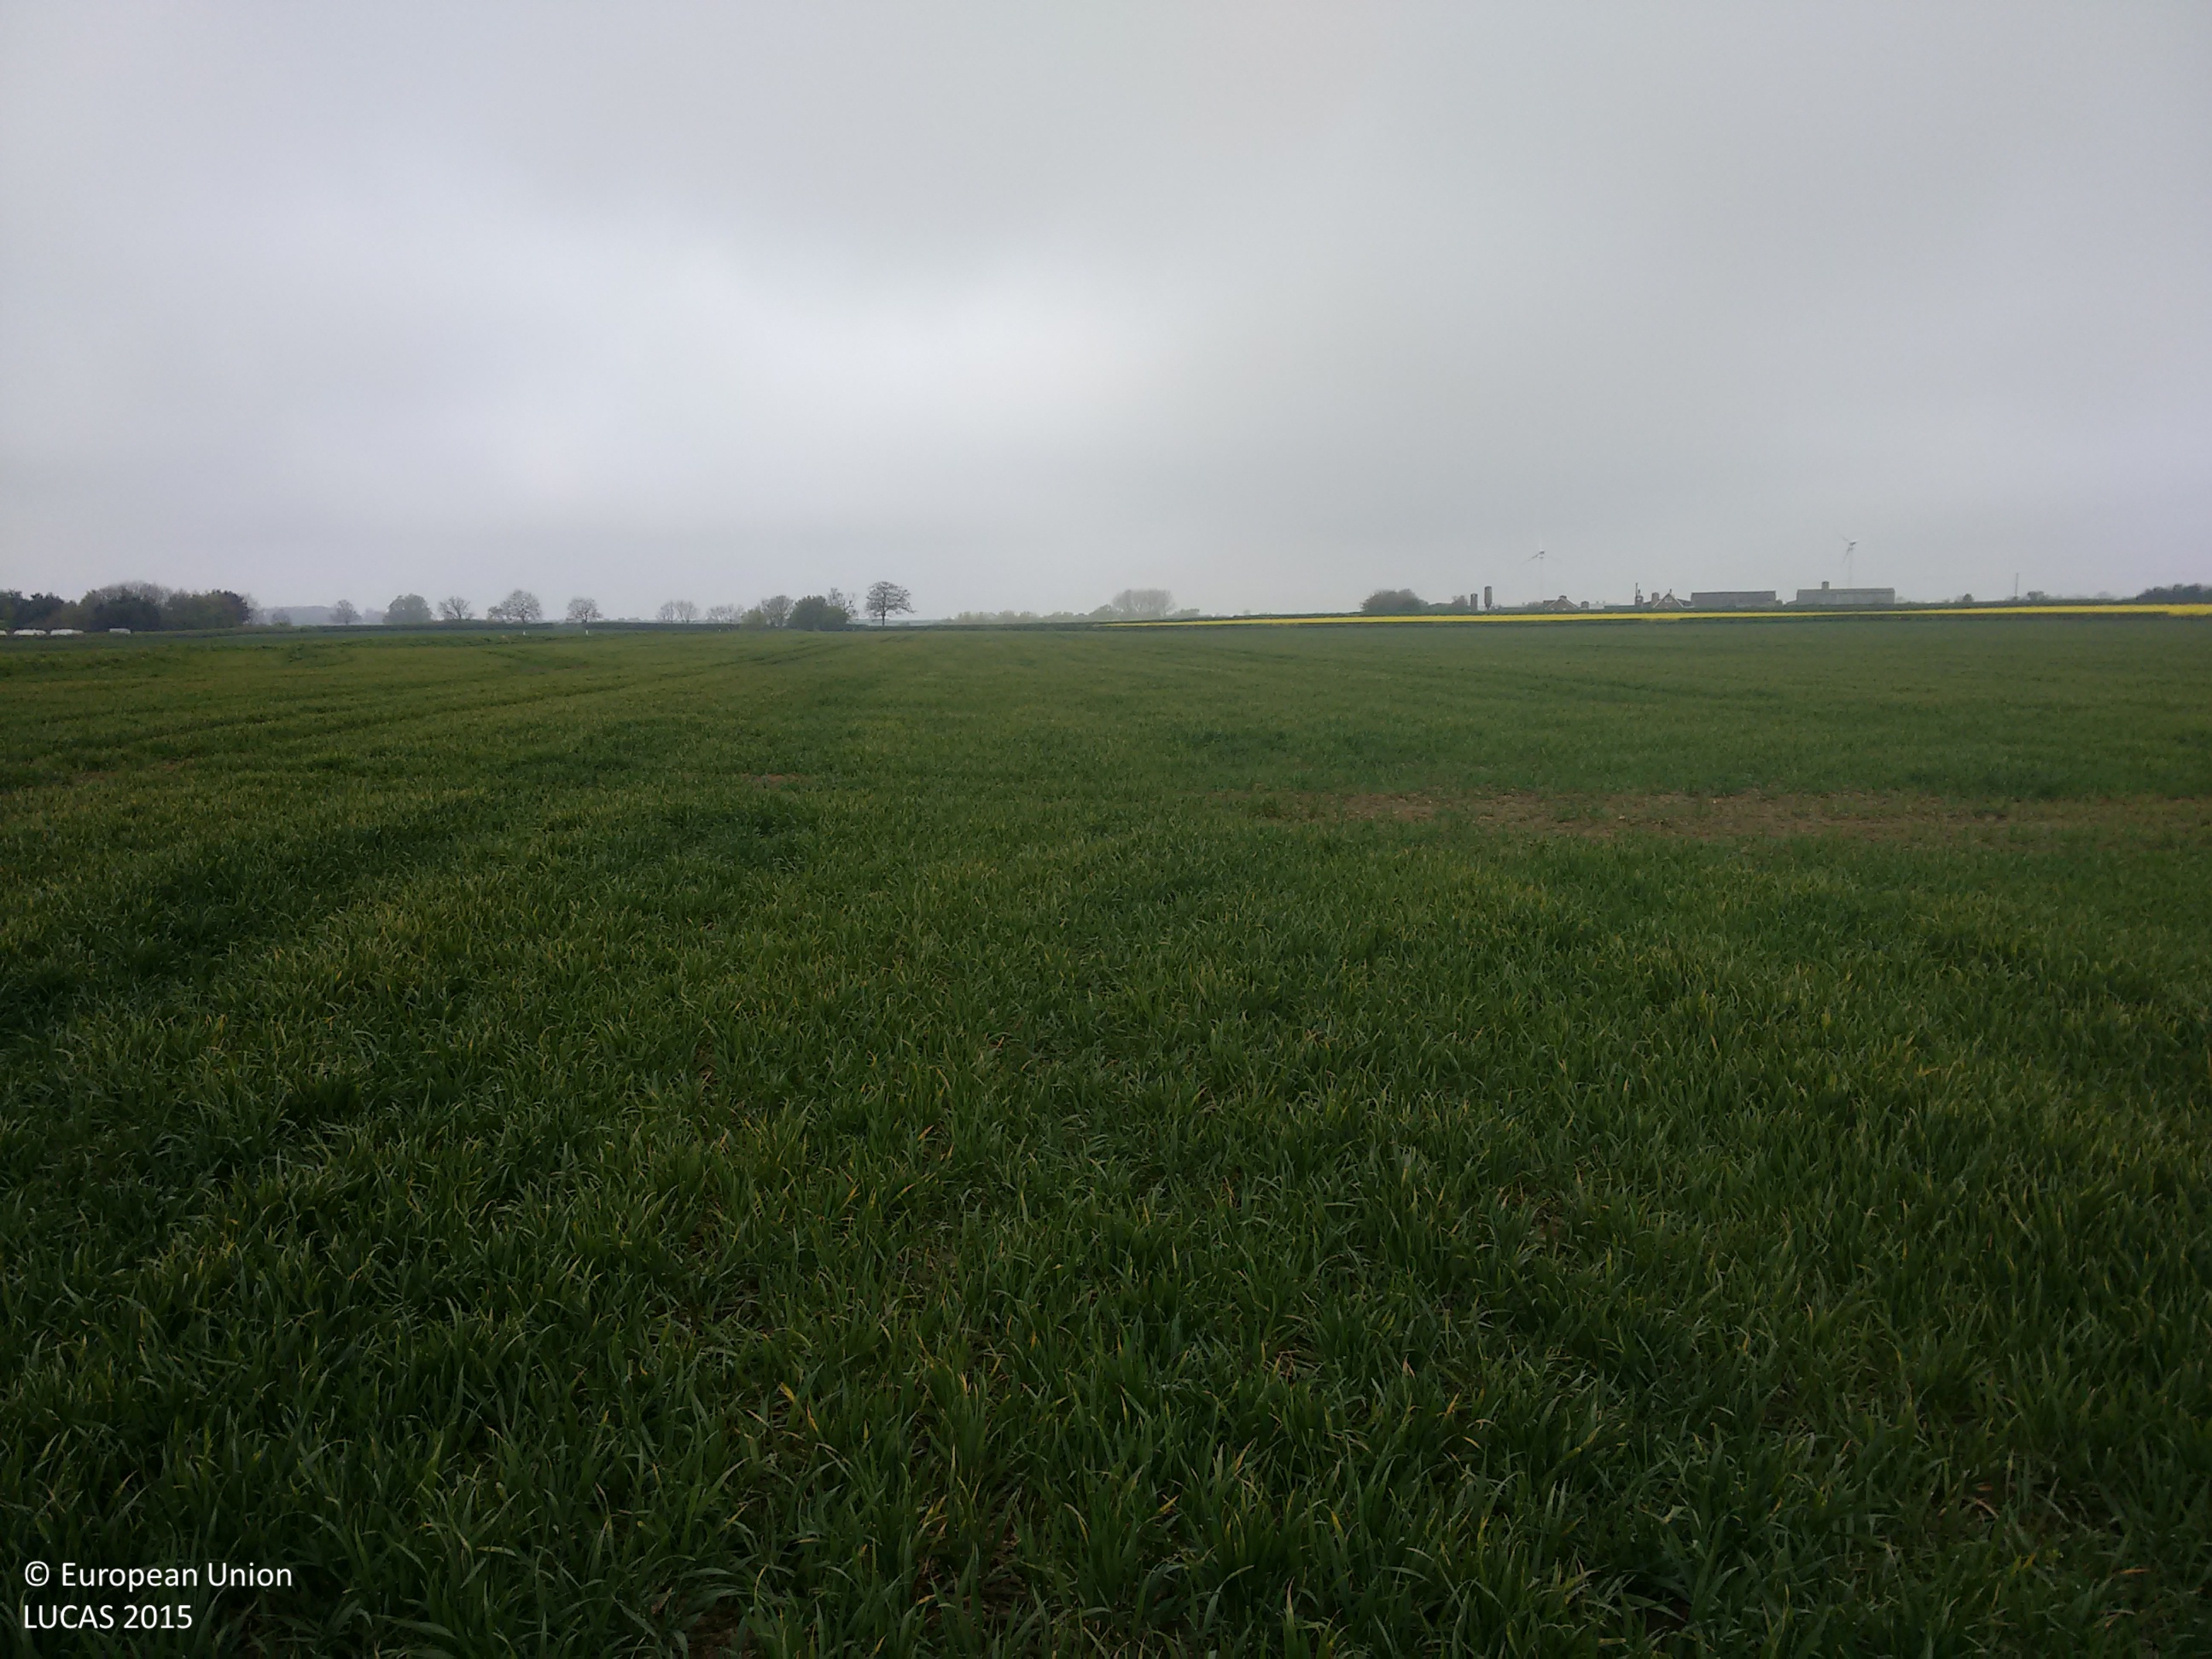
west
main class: Cropland
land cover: Common wheat
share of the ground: > 75 %
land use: Agriculture (excluding fallow land and kitchen gardens)
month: May
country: GB
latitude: 53.9772
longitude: -0.2957
